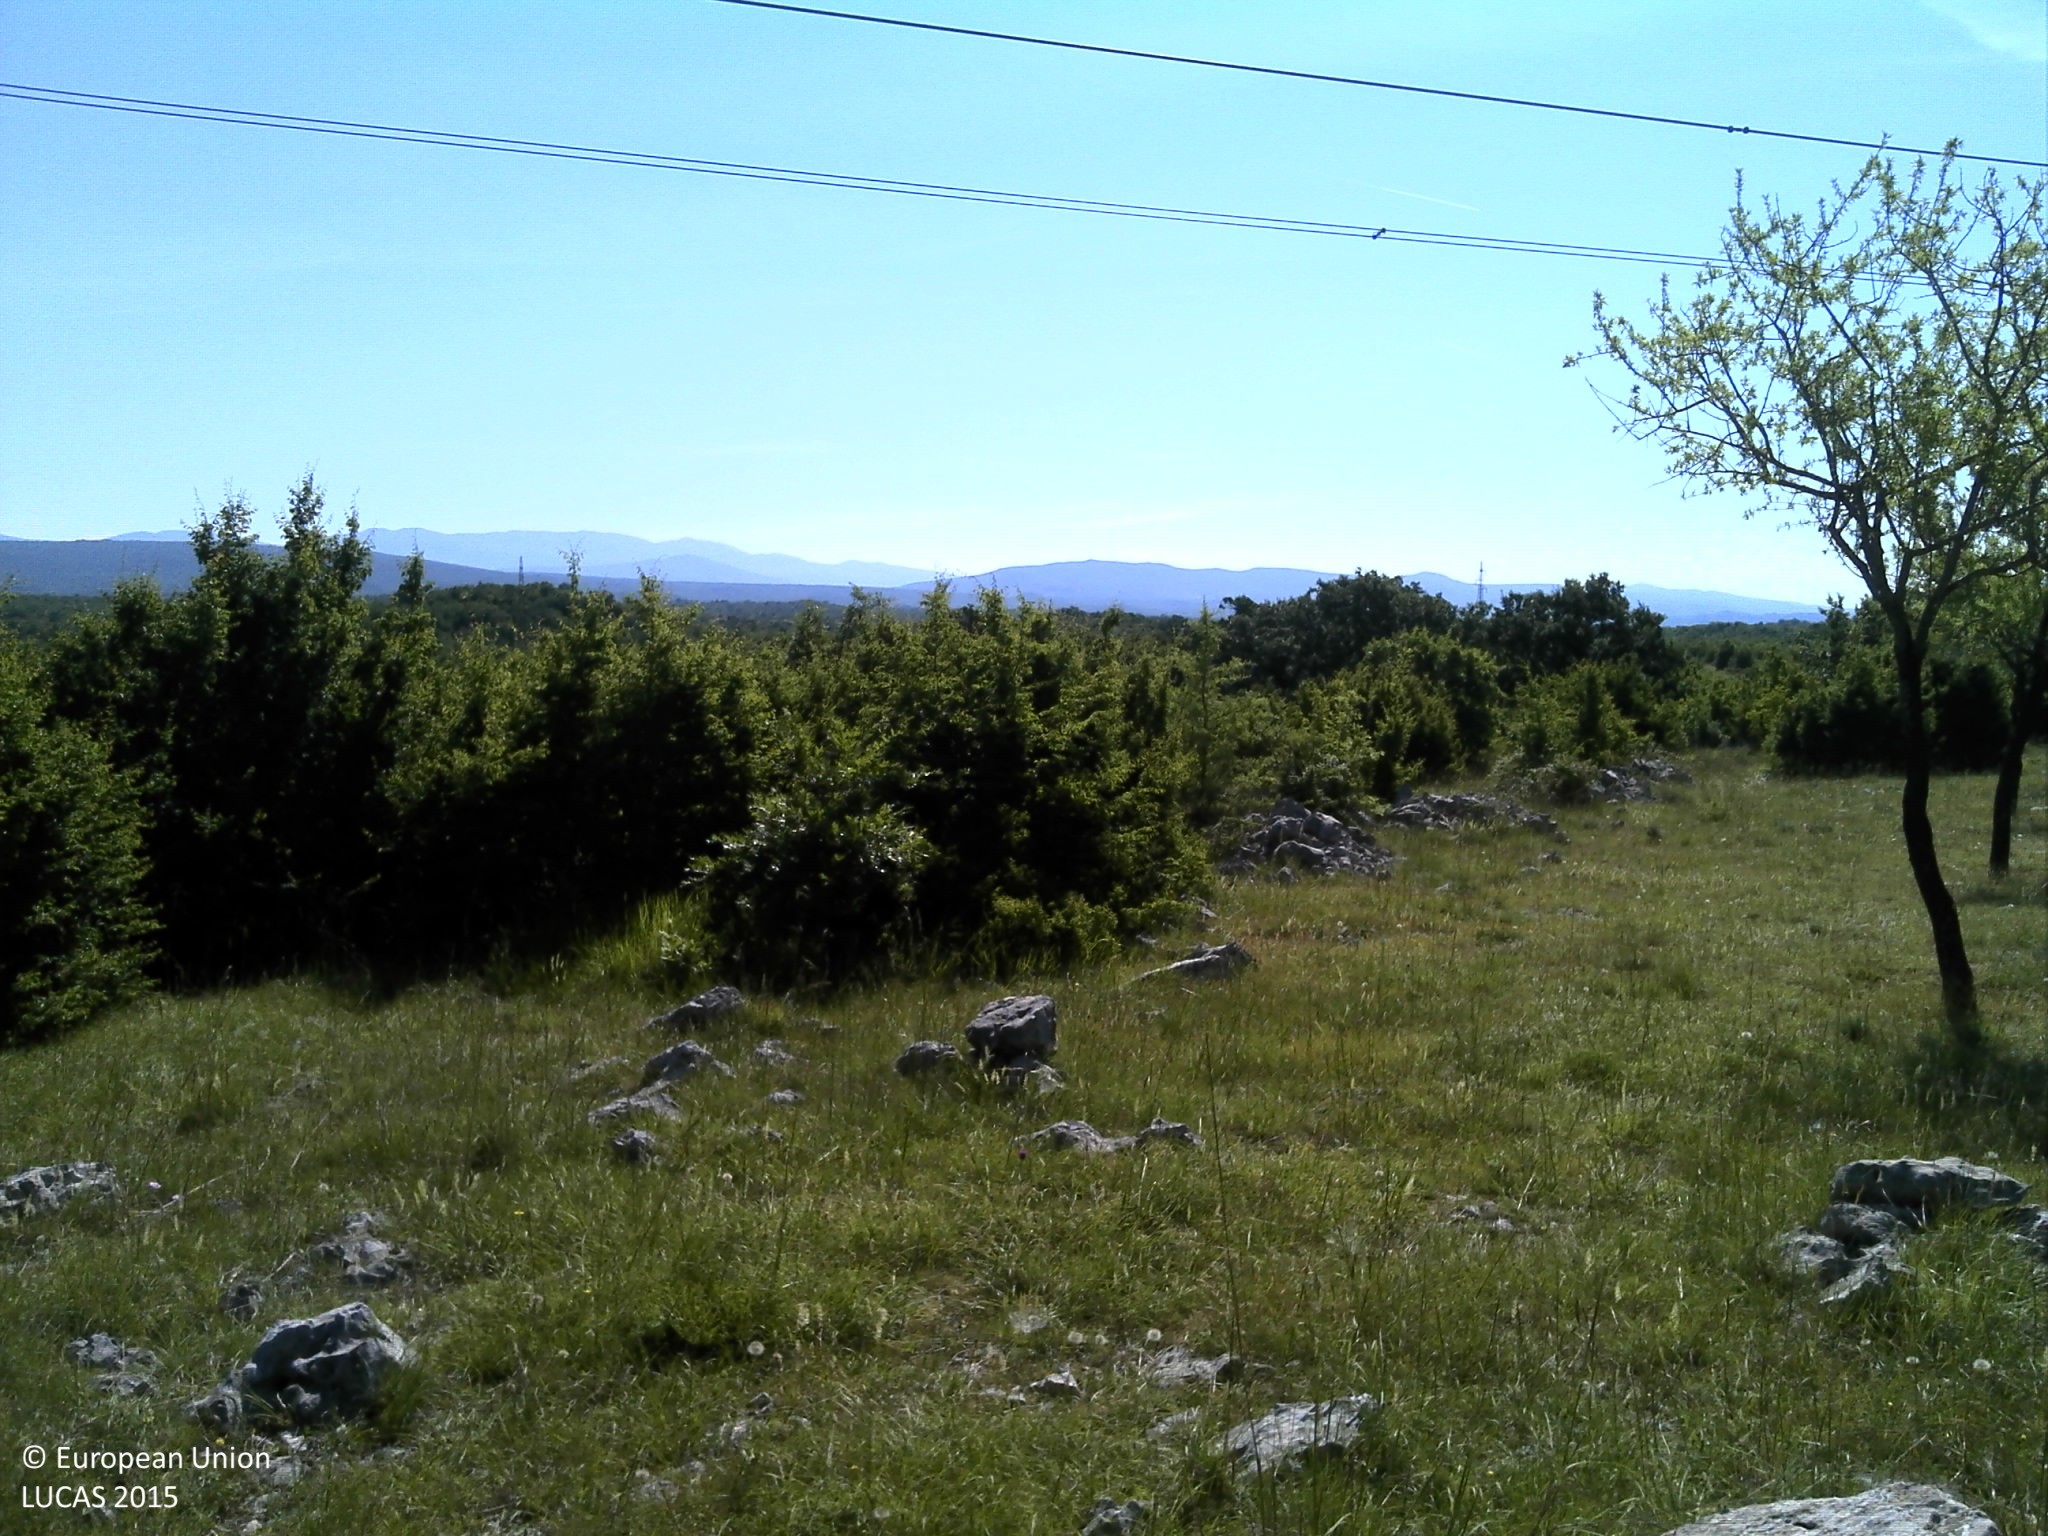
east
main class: Cropland
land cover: Nuts trees
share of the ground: < 10 %
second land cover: Spontaneously vegetated surfaces
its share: > 75 %
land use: Agriculture (excluding fallow land and kitchen gardens)
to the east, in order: Nuts trees; Spontaneously vegetated surfaces; Dry stone walls; Electric lines; Shrubland with sparse tree cover; Tracks; Shrubland with sparse tree cover; Broadleaved woodland; Shrubland with sparse tree cover; Broadleaved woodland
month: June
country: HR
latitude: 43.7513
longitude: 16.1637
